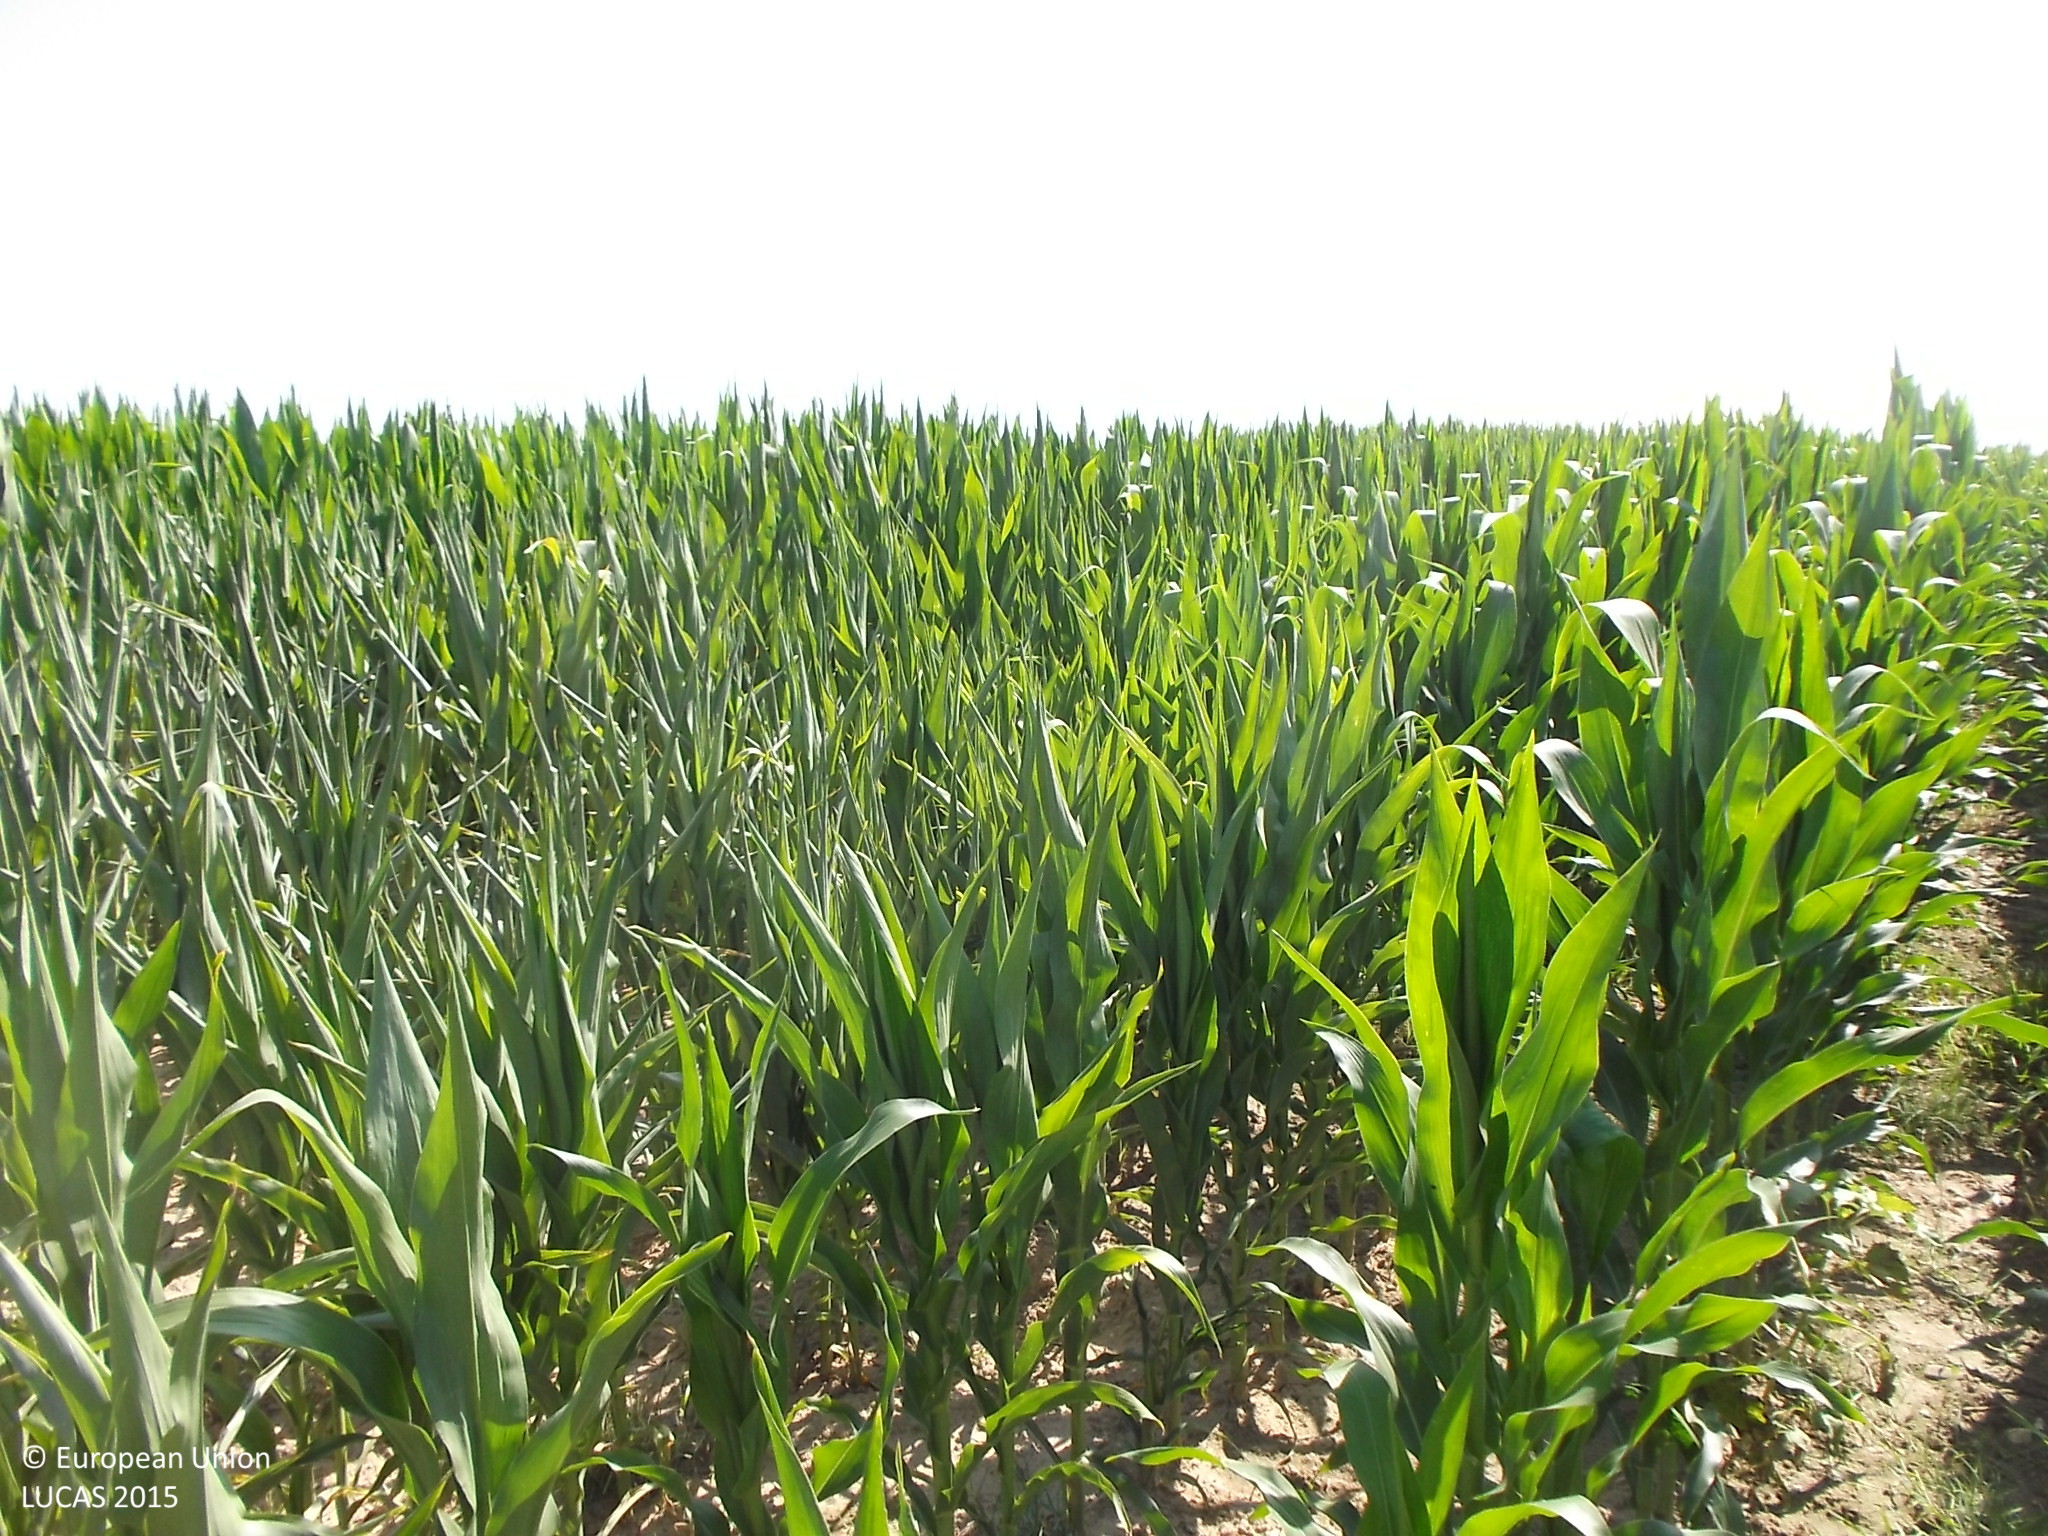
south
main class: Cropland
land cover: Maize
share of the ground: > 75 %
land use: Agriculture (excluding fallow land and kitchen gardens)
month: July
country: ES
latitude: 41.4484
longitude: -5.2906
